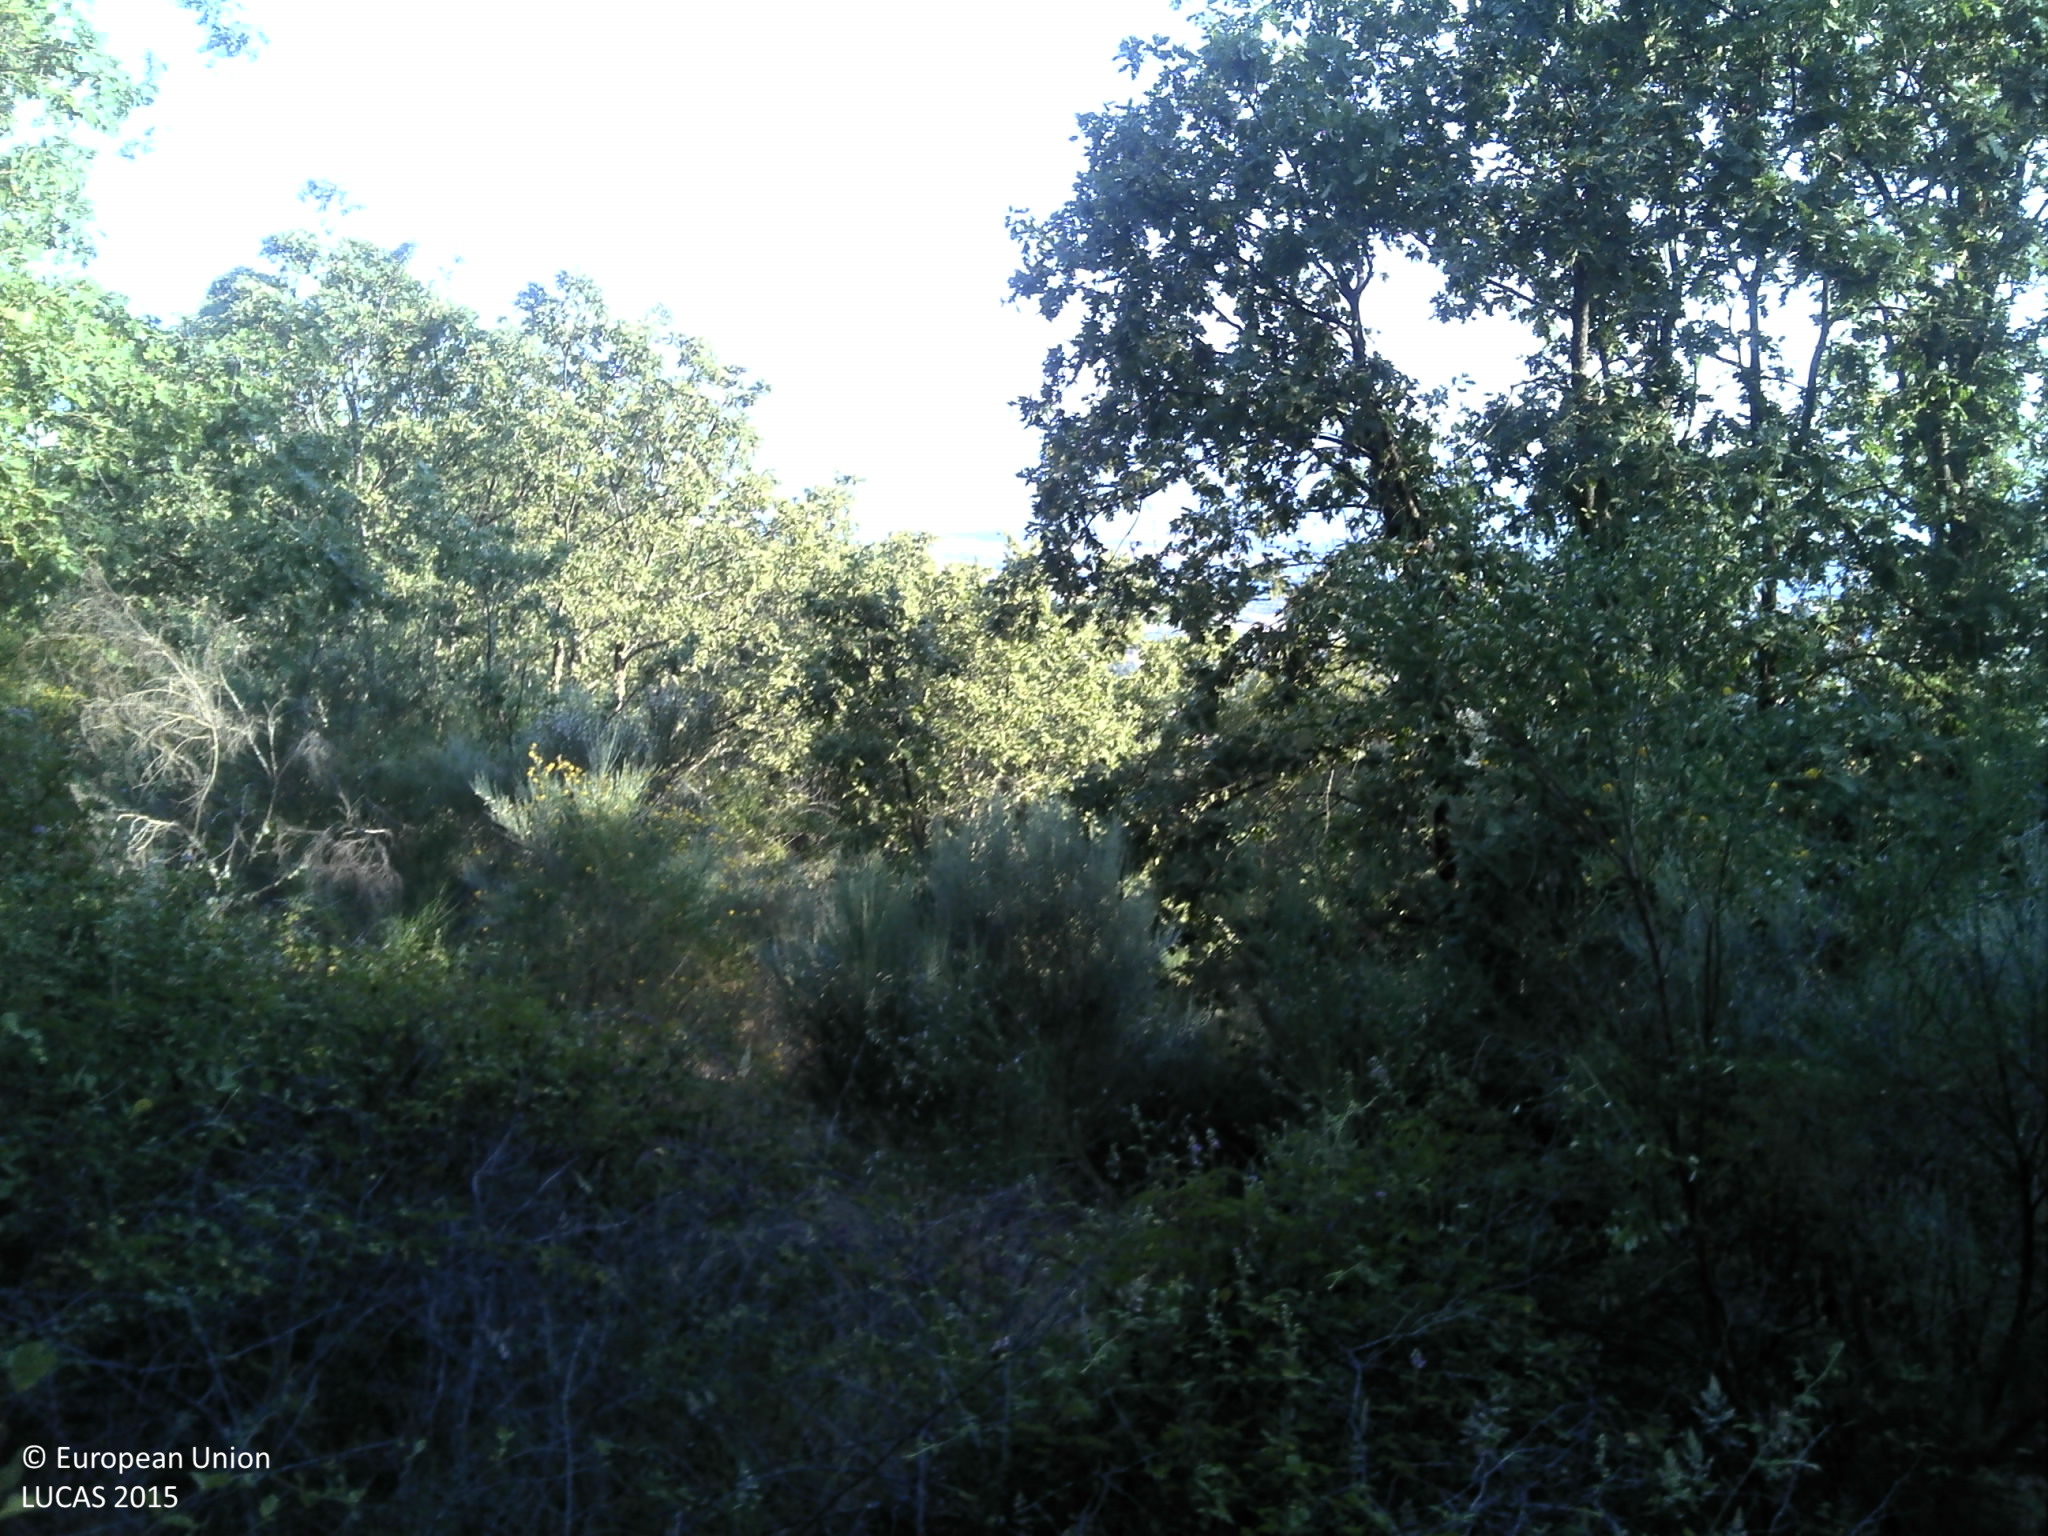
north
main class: Woodland
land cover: Broadleaved woodland
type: acidophilous oak and oak-birch forest
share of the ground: 50 - 75 %
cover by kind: broadleaved forest trees 65 %, shrubs 25 %, unconsolidated bare surface 5 %
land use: Forestry
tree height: > 5 m
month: June
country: PT
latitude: 40.2320
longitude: -7.3926
